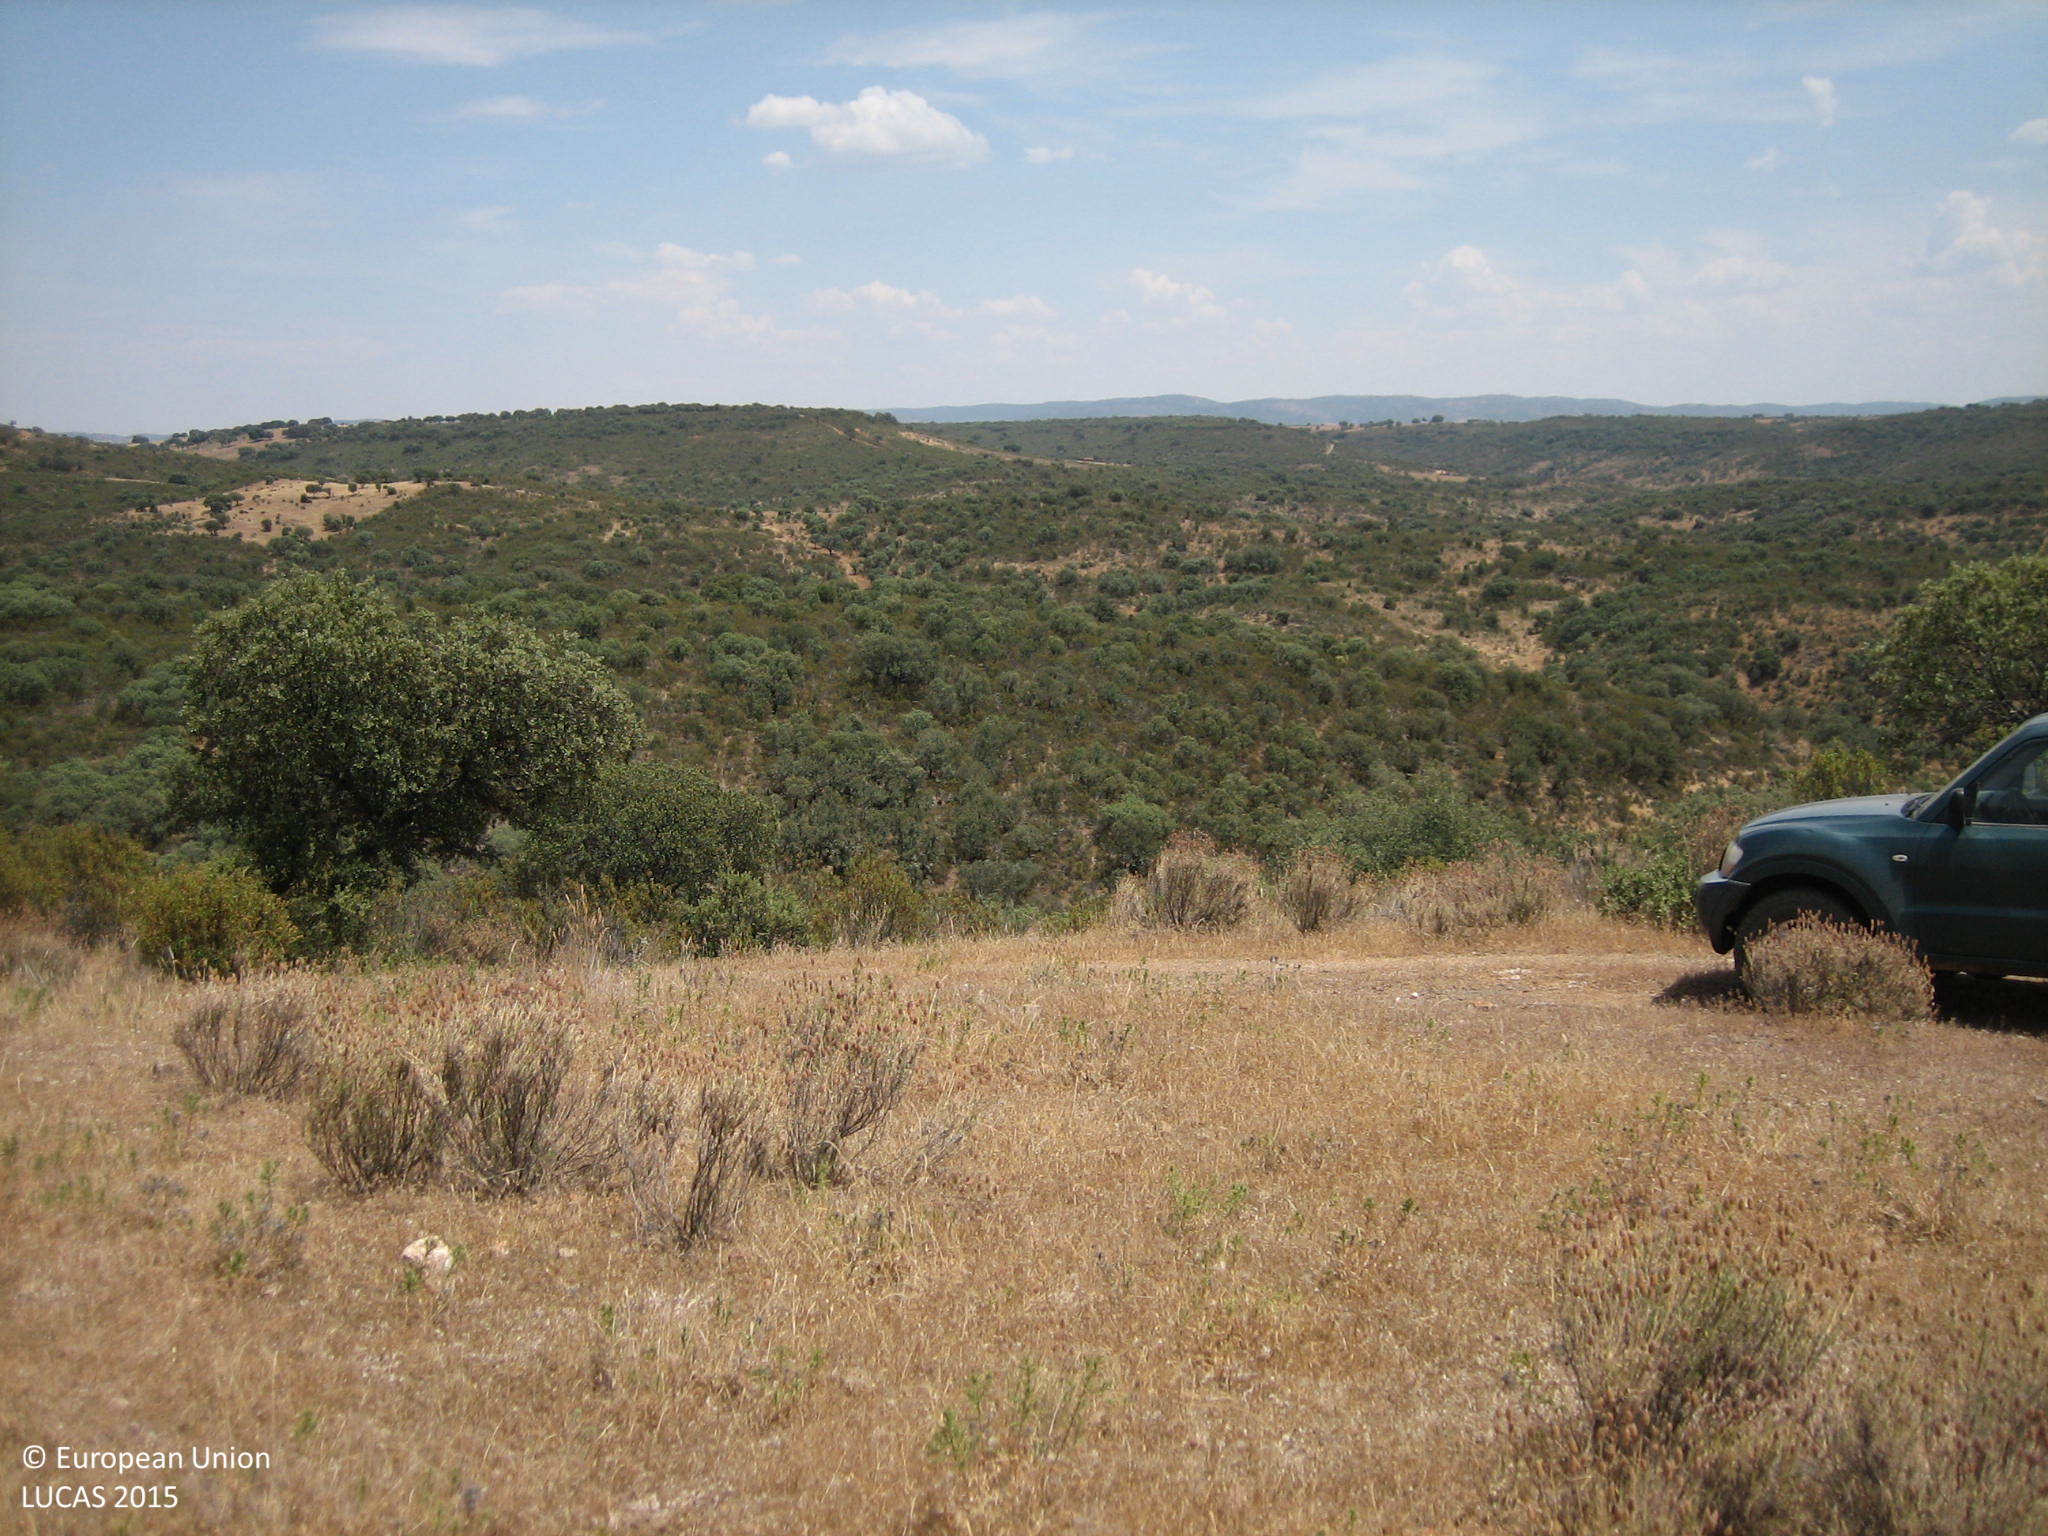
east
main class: Shrubland
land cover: Shrubland without tree cover
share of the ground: 50 - 75 %
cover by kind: shrubs 50 %, herbaceous plants 50 %
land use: Agriculture (excluding fallow land and kitchen gardens)
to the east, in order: Shrubland without tree cover; Tracks; Shrubland with sparse tree cover; Rivers and streams; Shrubland with sparse tree cover
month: June
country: ES
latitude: 39.2035
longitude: -4.6121
